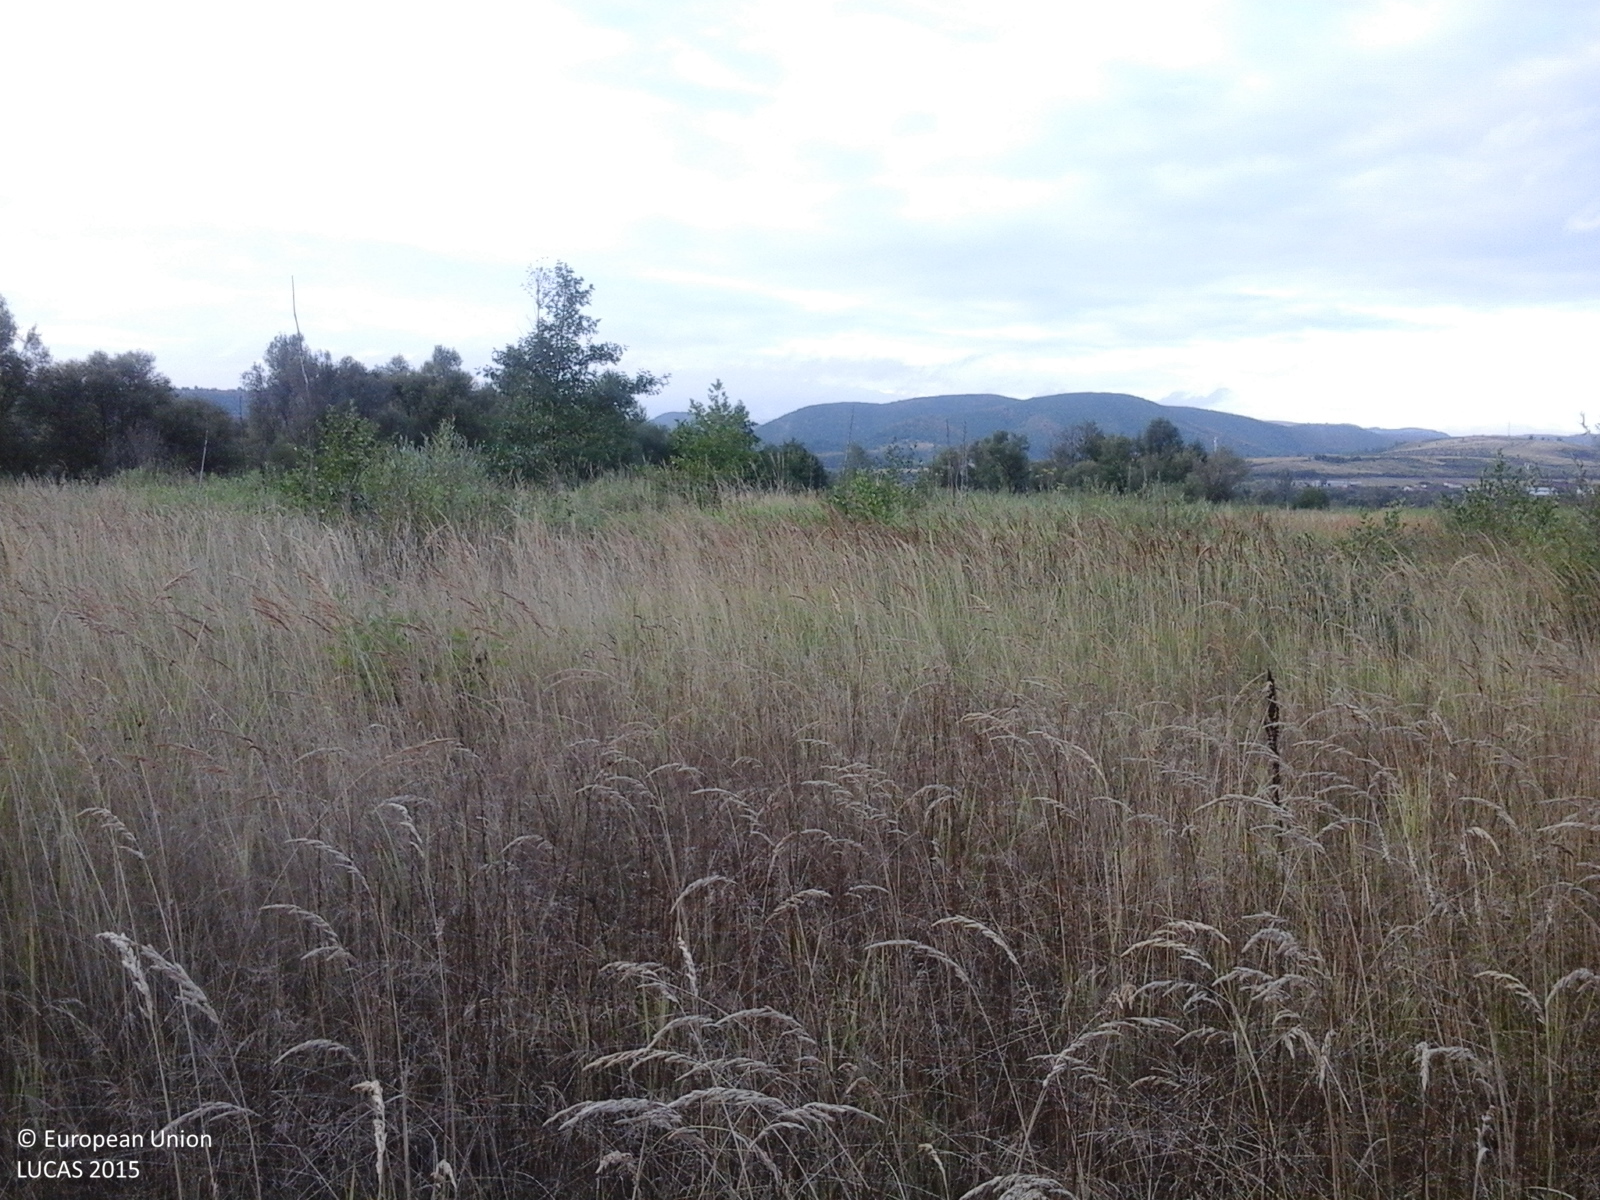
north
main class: Grassland
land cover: Spontaneously vegetated surfaces
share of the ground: > 75 %
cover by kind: herbaceous plants 100 %
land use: Fallow land
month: August
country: RO
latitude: 44.9079
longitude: 22.0037
